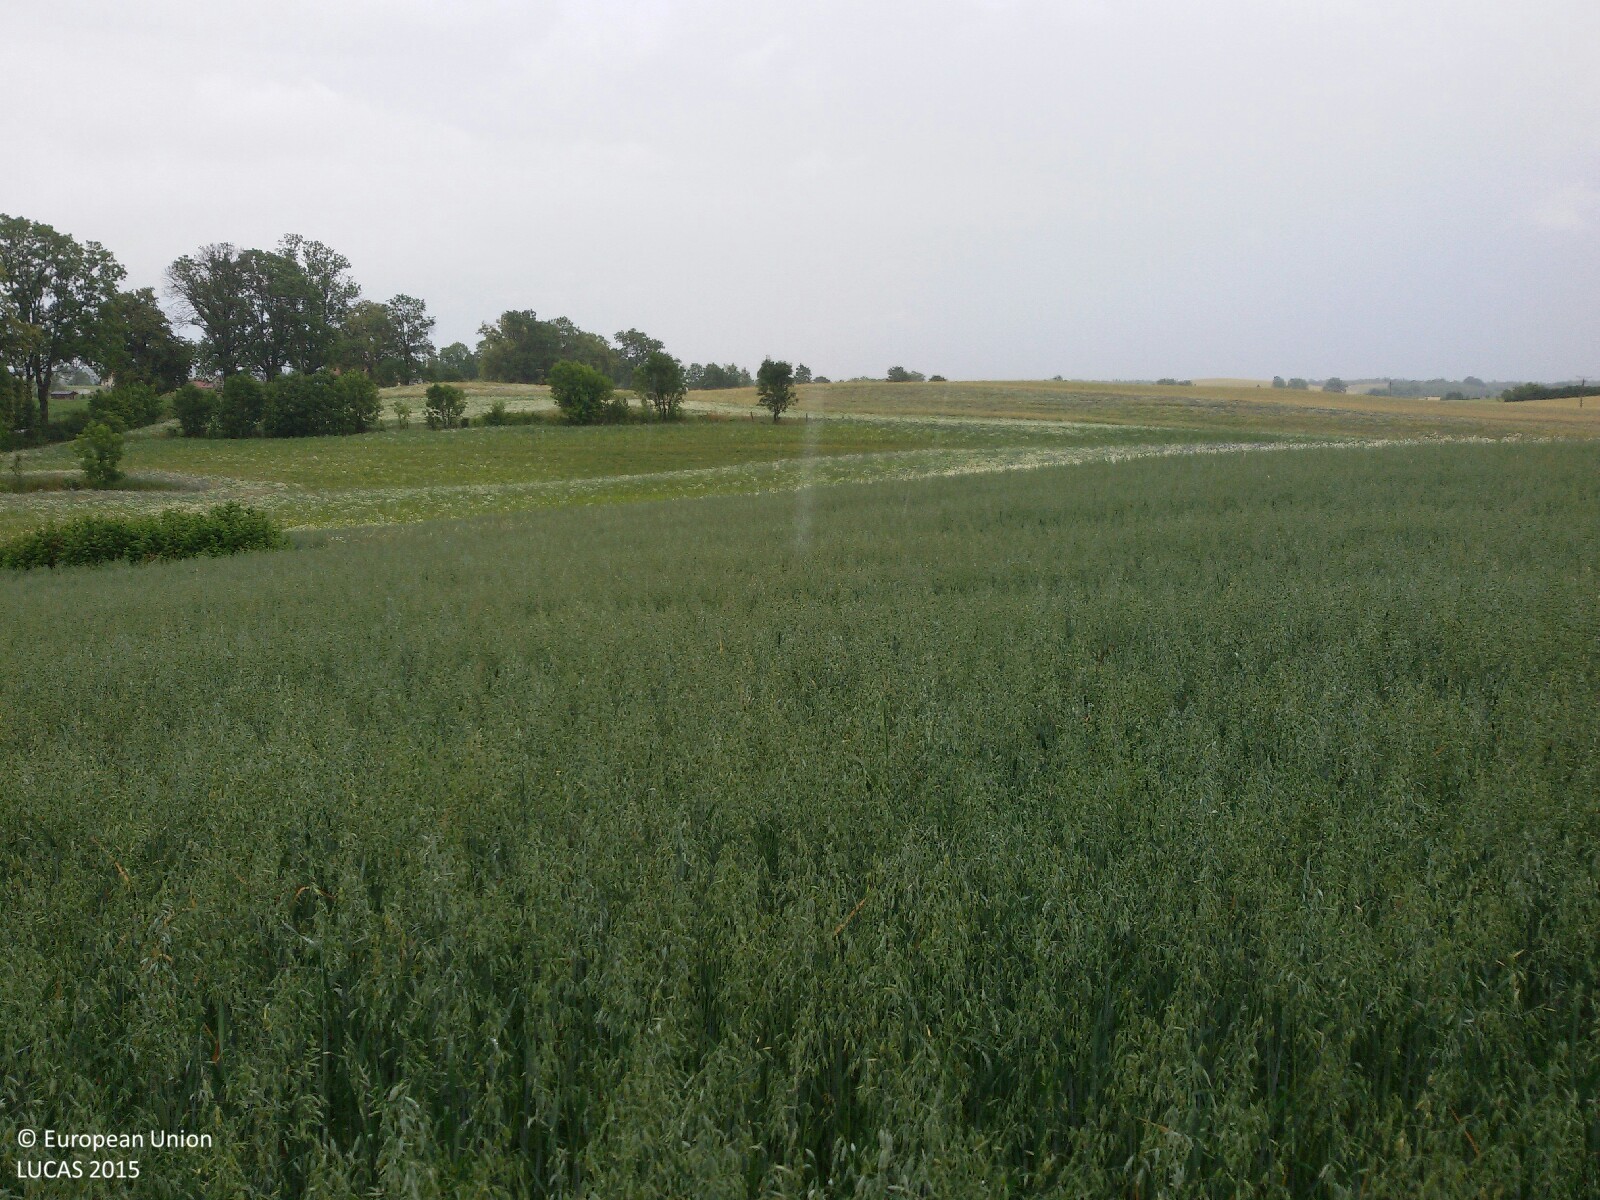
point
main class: Cropland
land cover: Oats
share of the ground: > 75 %
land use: Agriculture (excluding fallow land and kitchen gardens)
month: July
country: PL
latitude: 53.9265
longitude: 20.2524
